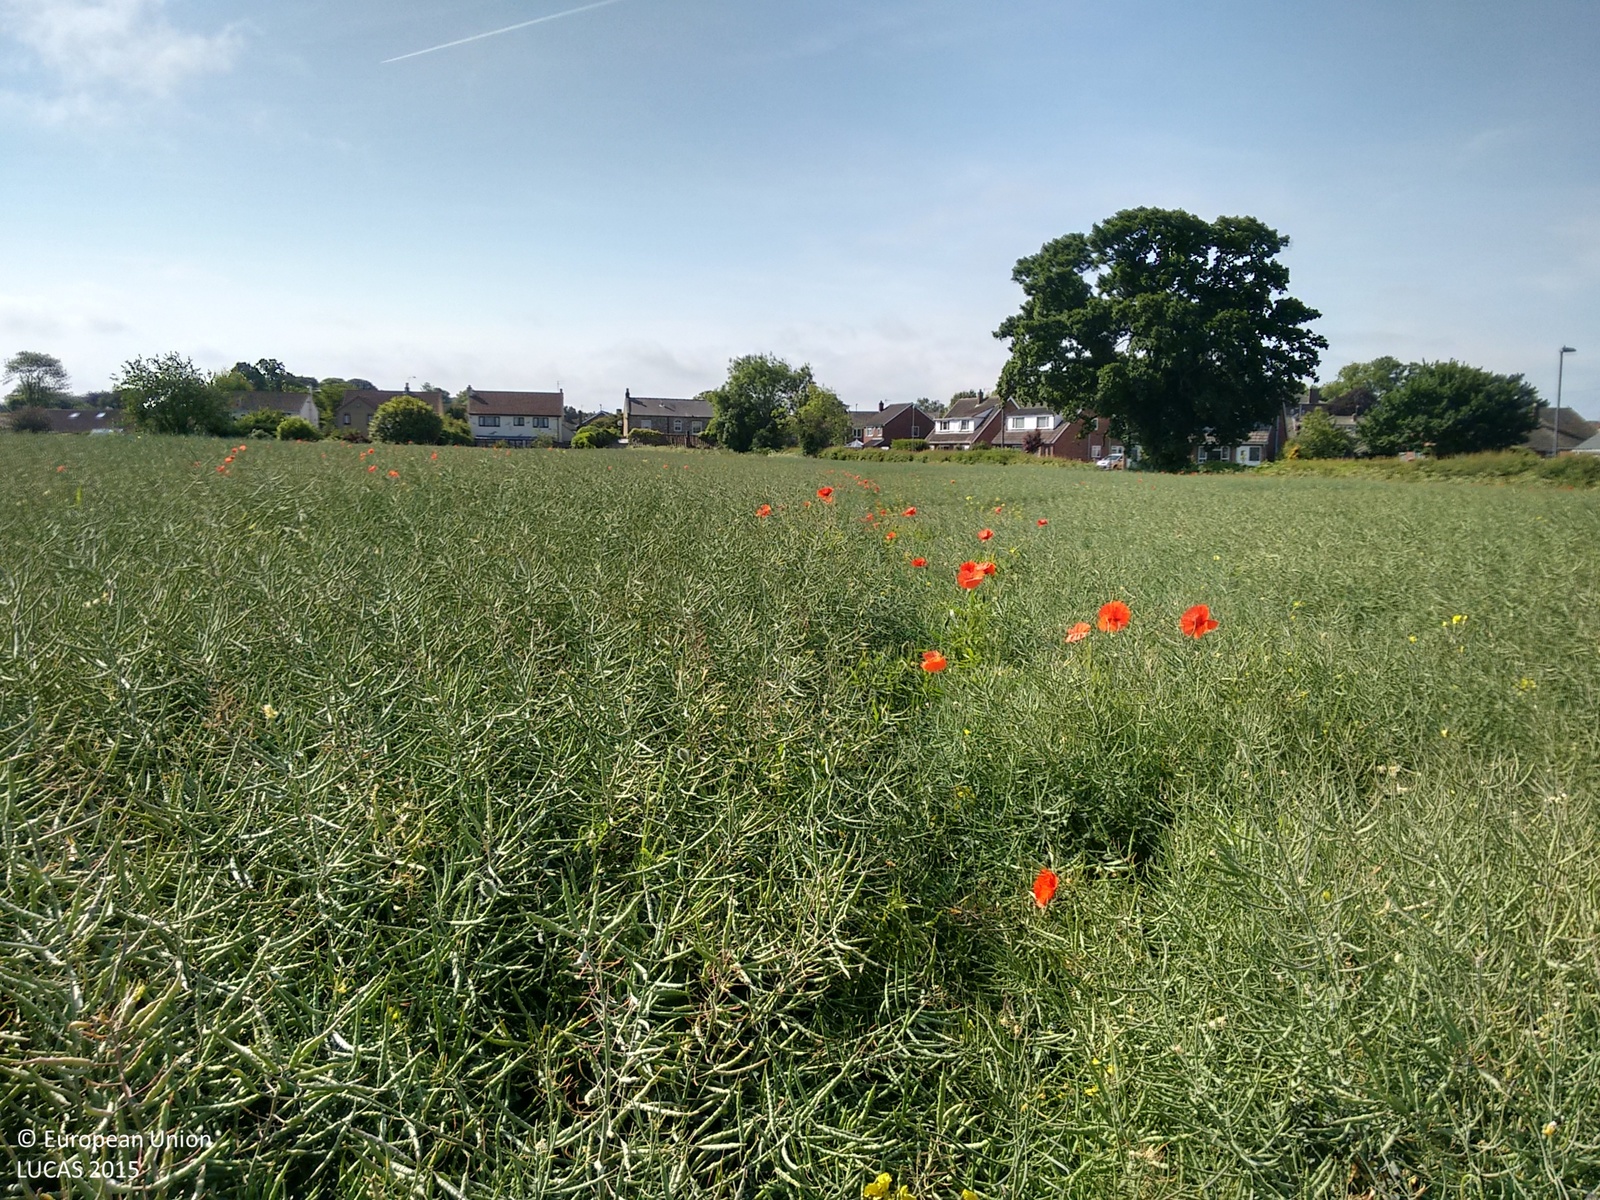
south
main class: Cropland
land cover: Rape and turnip rape
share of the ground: > 75 %
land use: Agriculture (excluding fallow land and kitchen gardens)
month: June
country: GB
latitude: 53.7733
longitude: -1.1672
